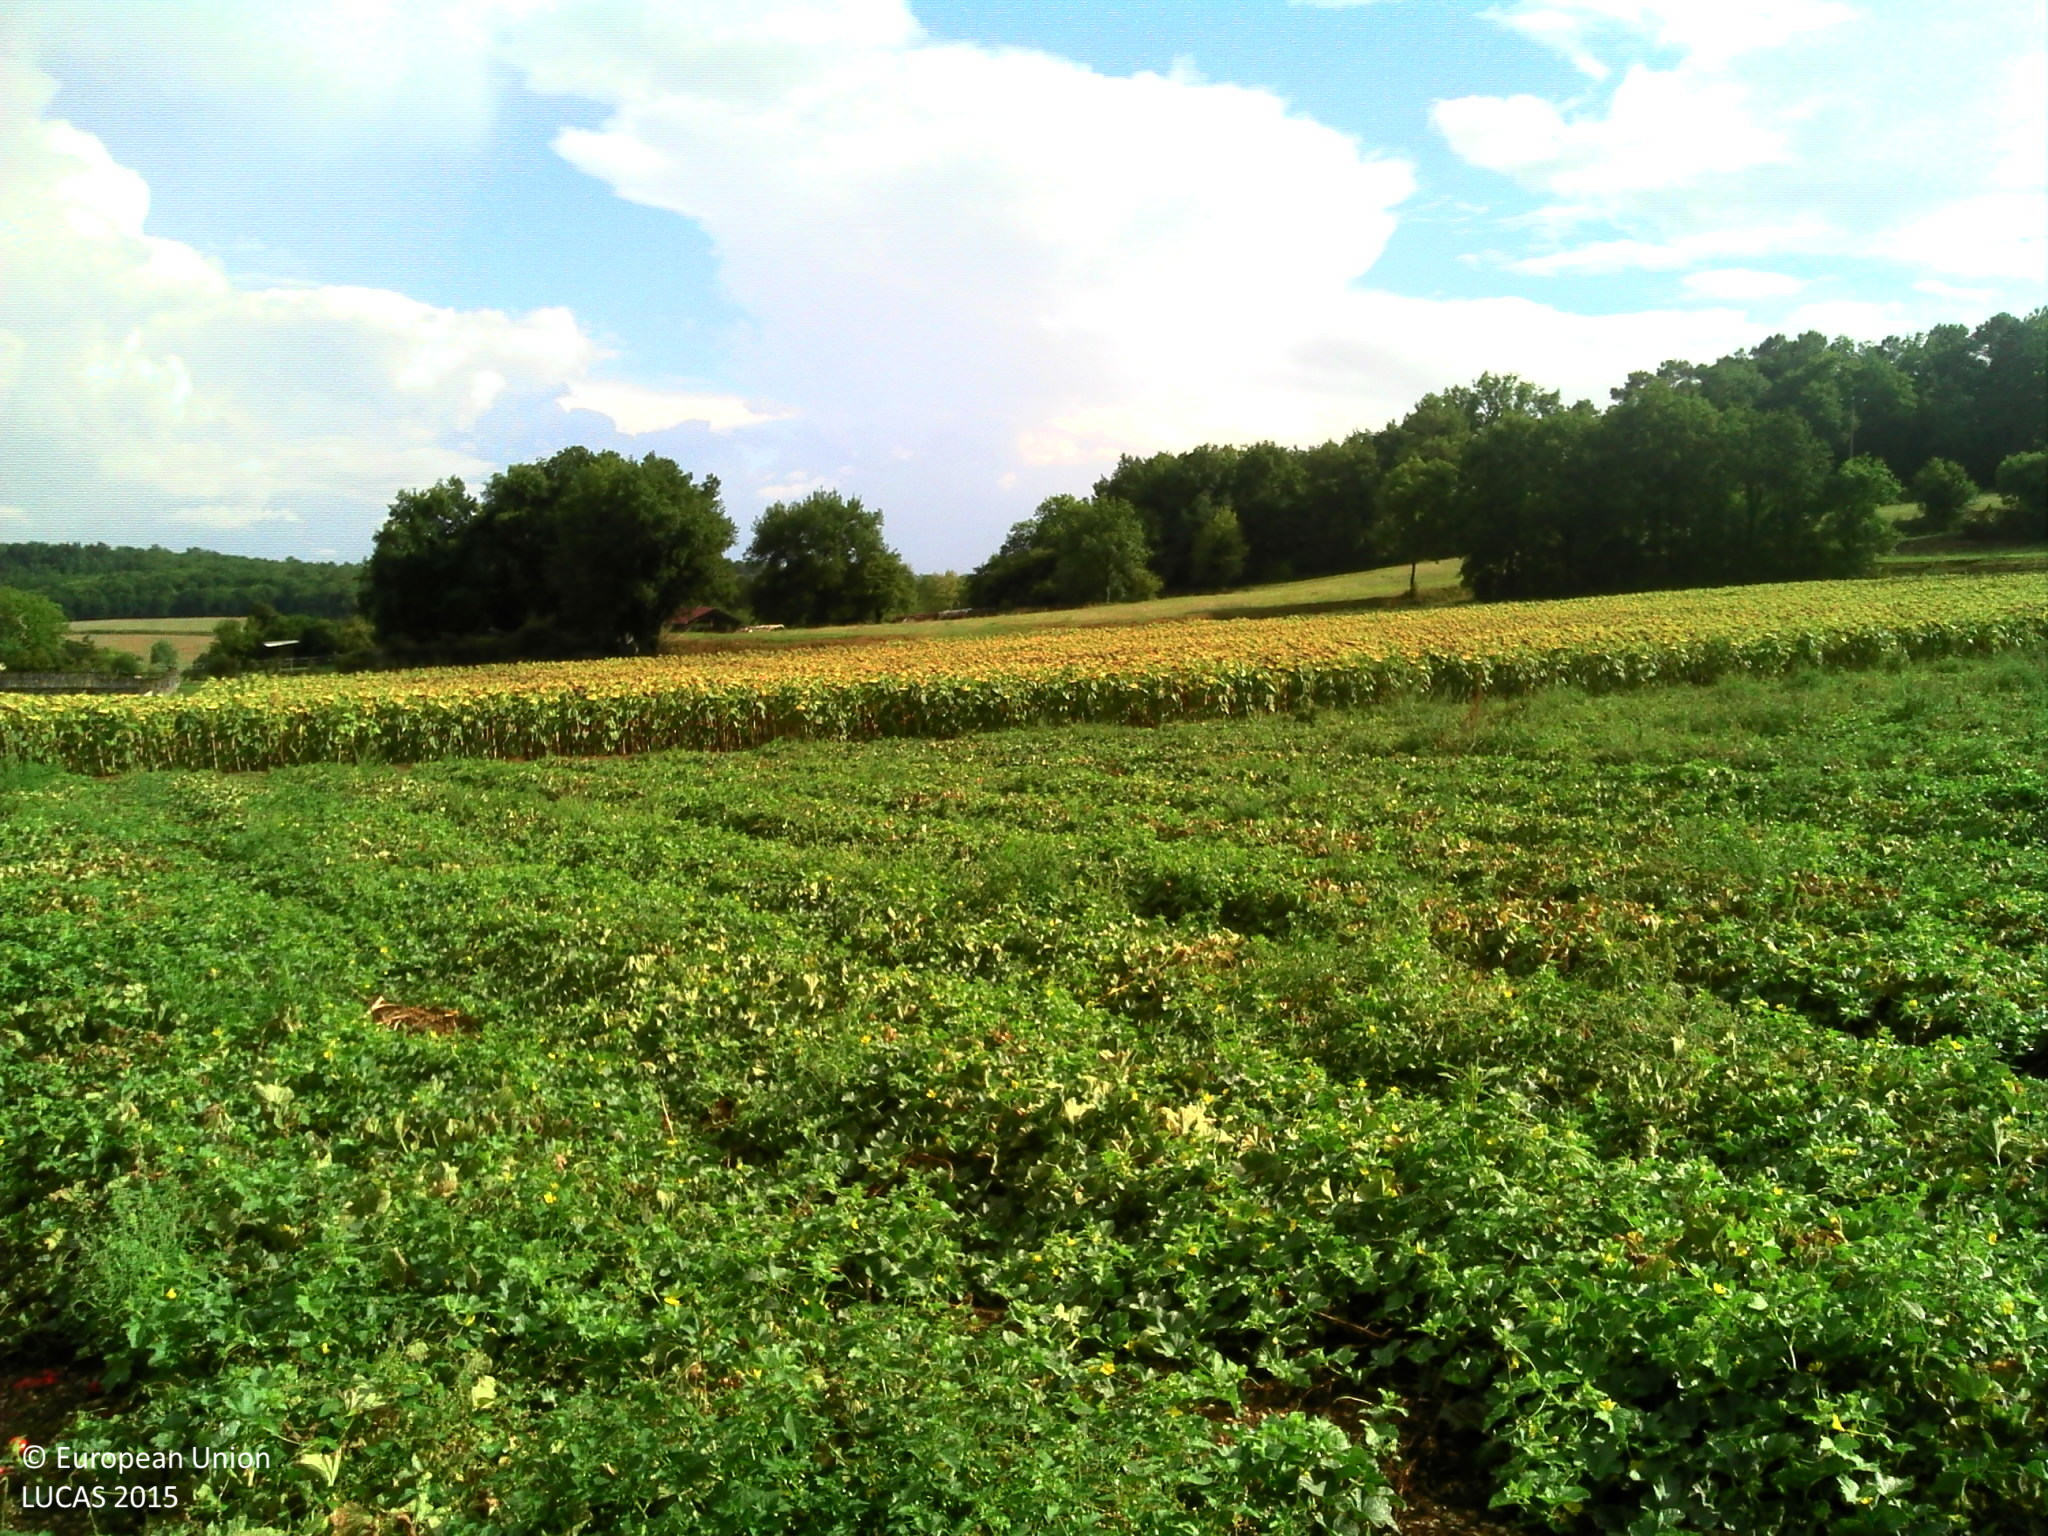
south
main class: Cropland
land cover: Other fresh vegetables
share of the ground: 25 - 50 %
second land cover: Tomatoes
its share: 10 - 25 %
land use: Agriculture (excluding fallow land and kitchen gardens)
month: August
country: FR
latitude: 45.3836
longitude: 0.7043
